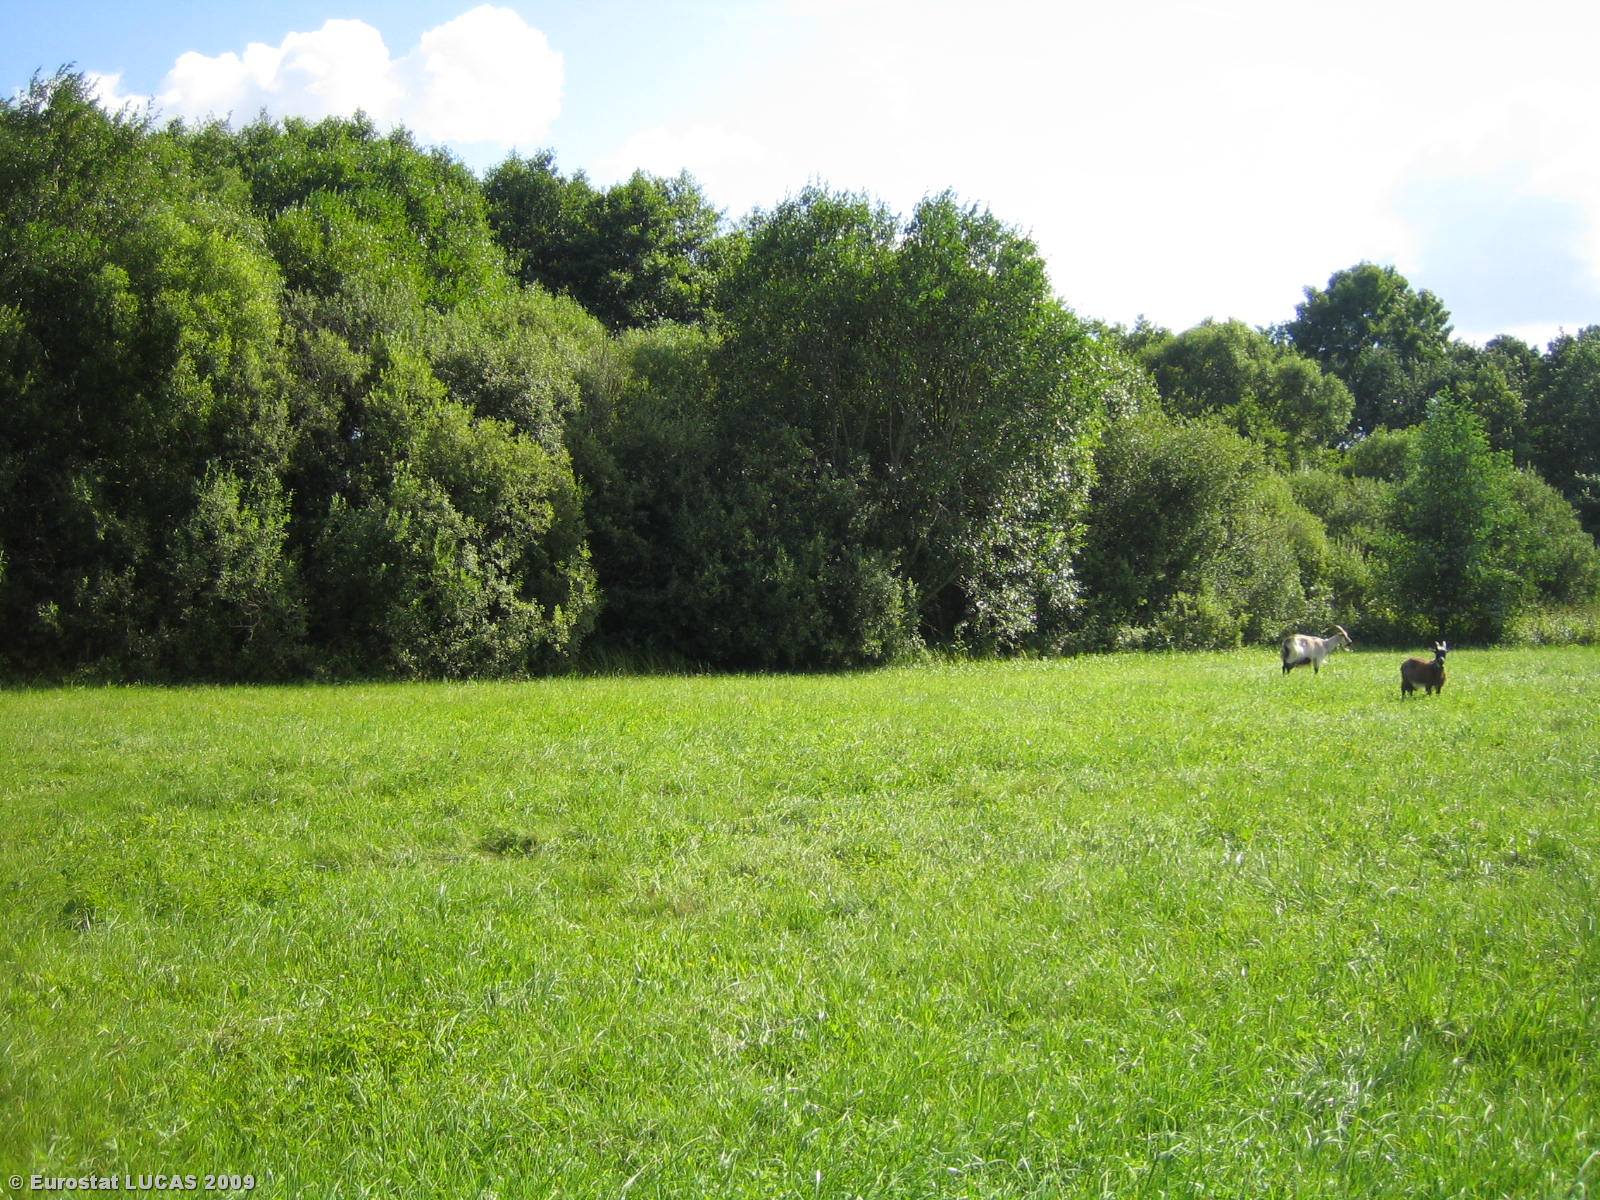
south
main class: Grassland
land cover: Grassland without tree/shrub cover
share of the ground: > 75 %
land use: Agriculture (excluding fallow land and kitchen gardens)
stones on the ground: < 10 %
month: August
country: LT
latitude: 54.7709
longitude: 24.5124
